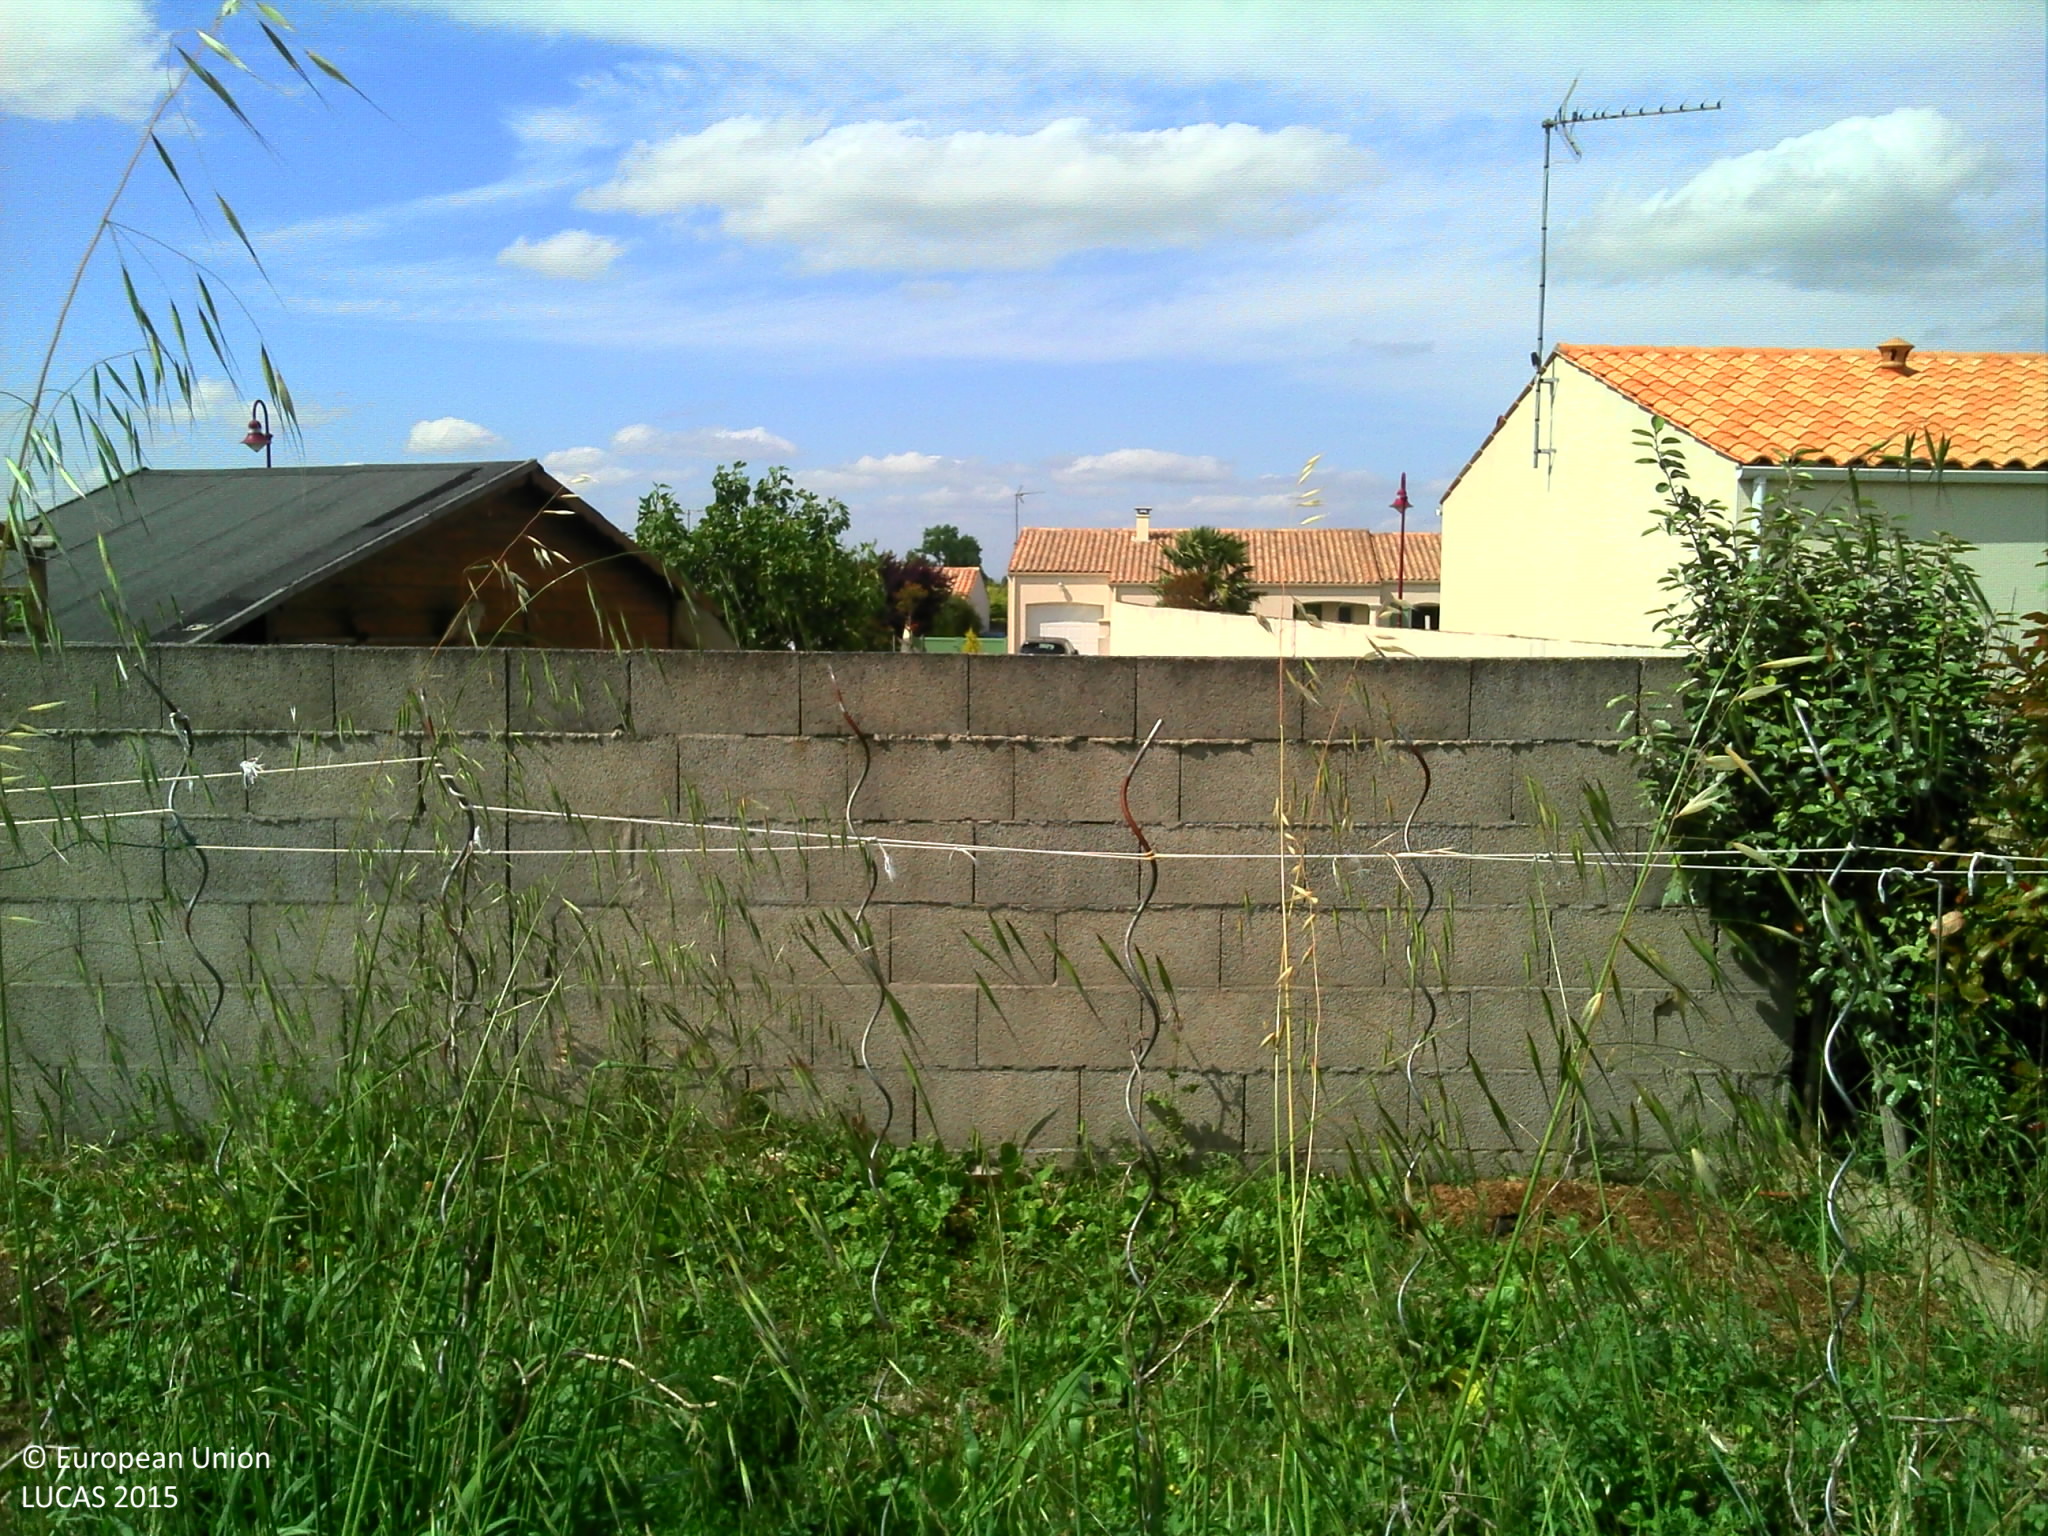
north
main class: Grassland
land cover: Grassland without tree/shrub cover
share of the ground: > 75 %
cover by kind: herbaceous plants 100 %
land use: Residential
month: June
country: FR
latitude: 46.3087
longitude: -1.0031
